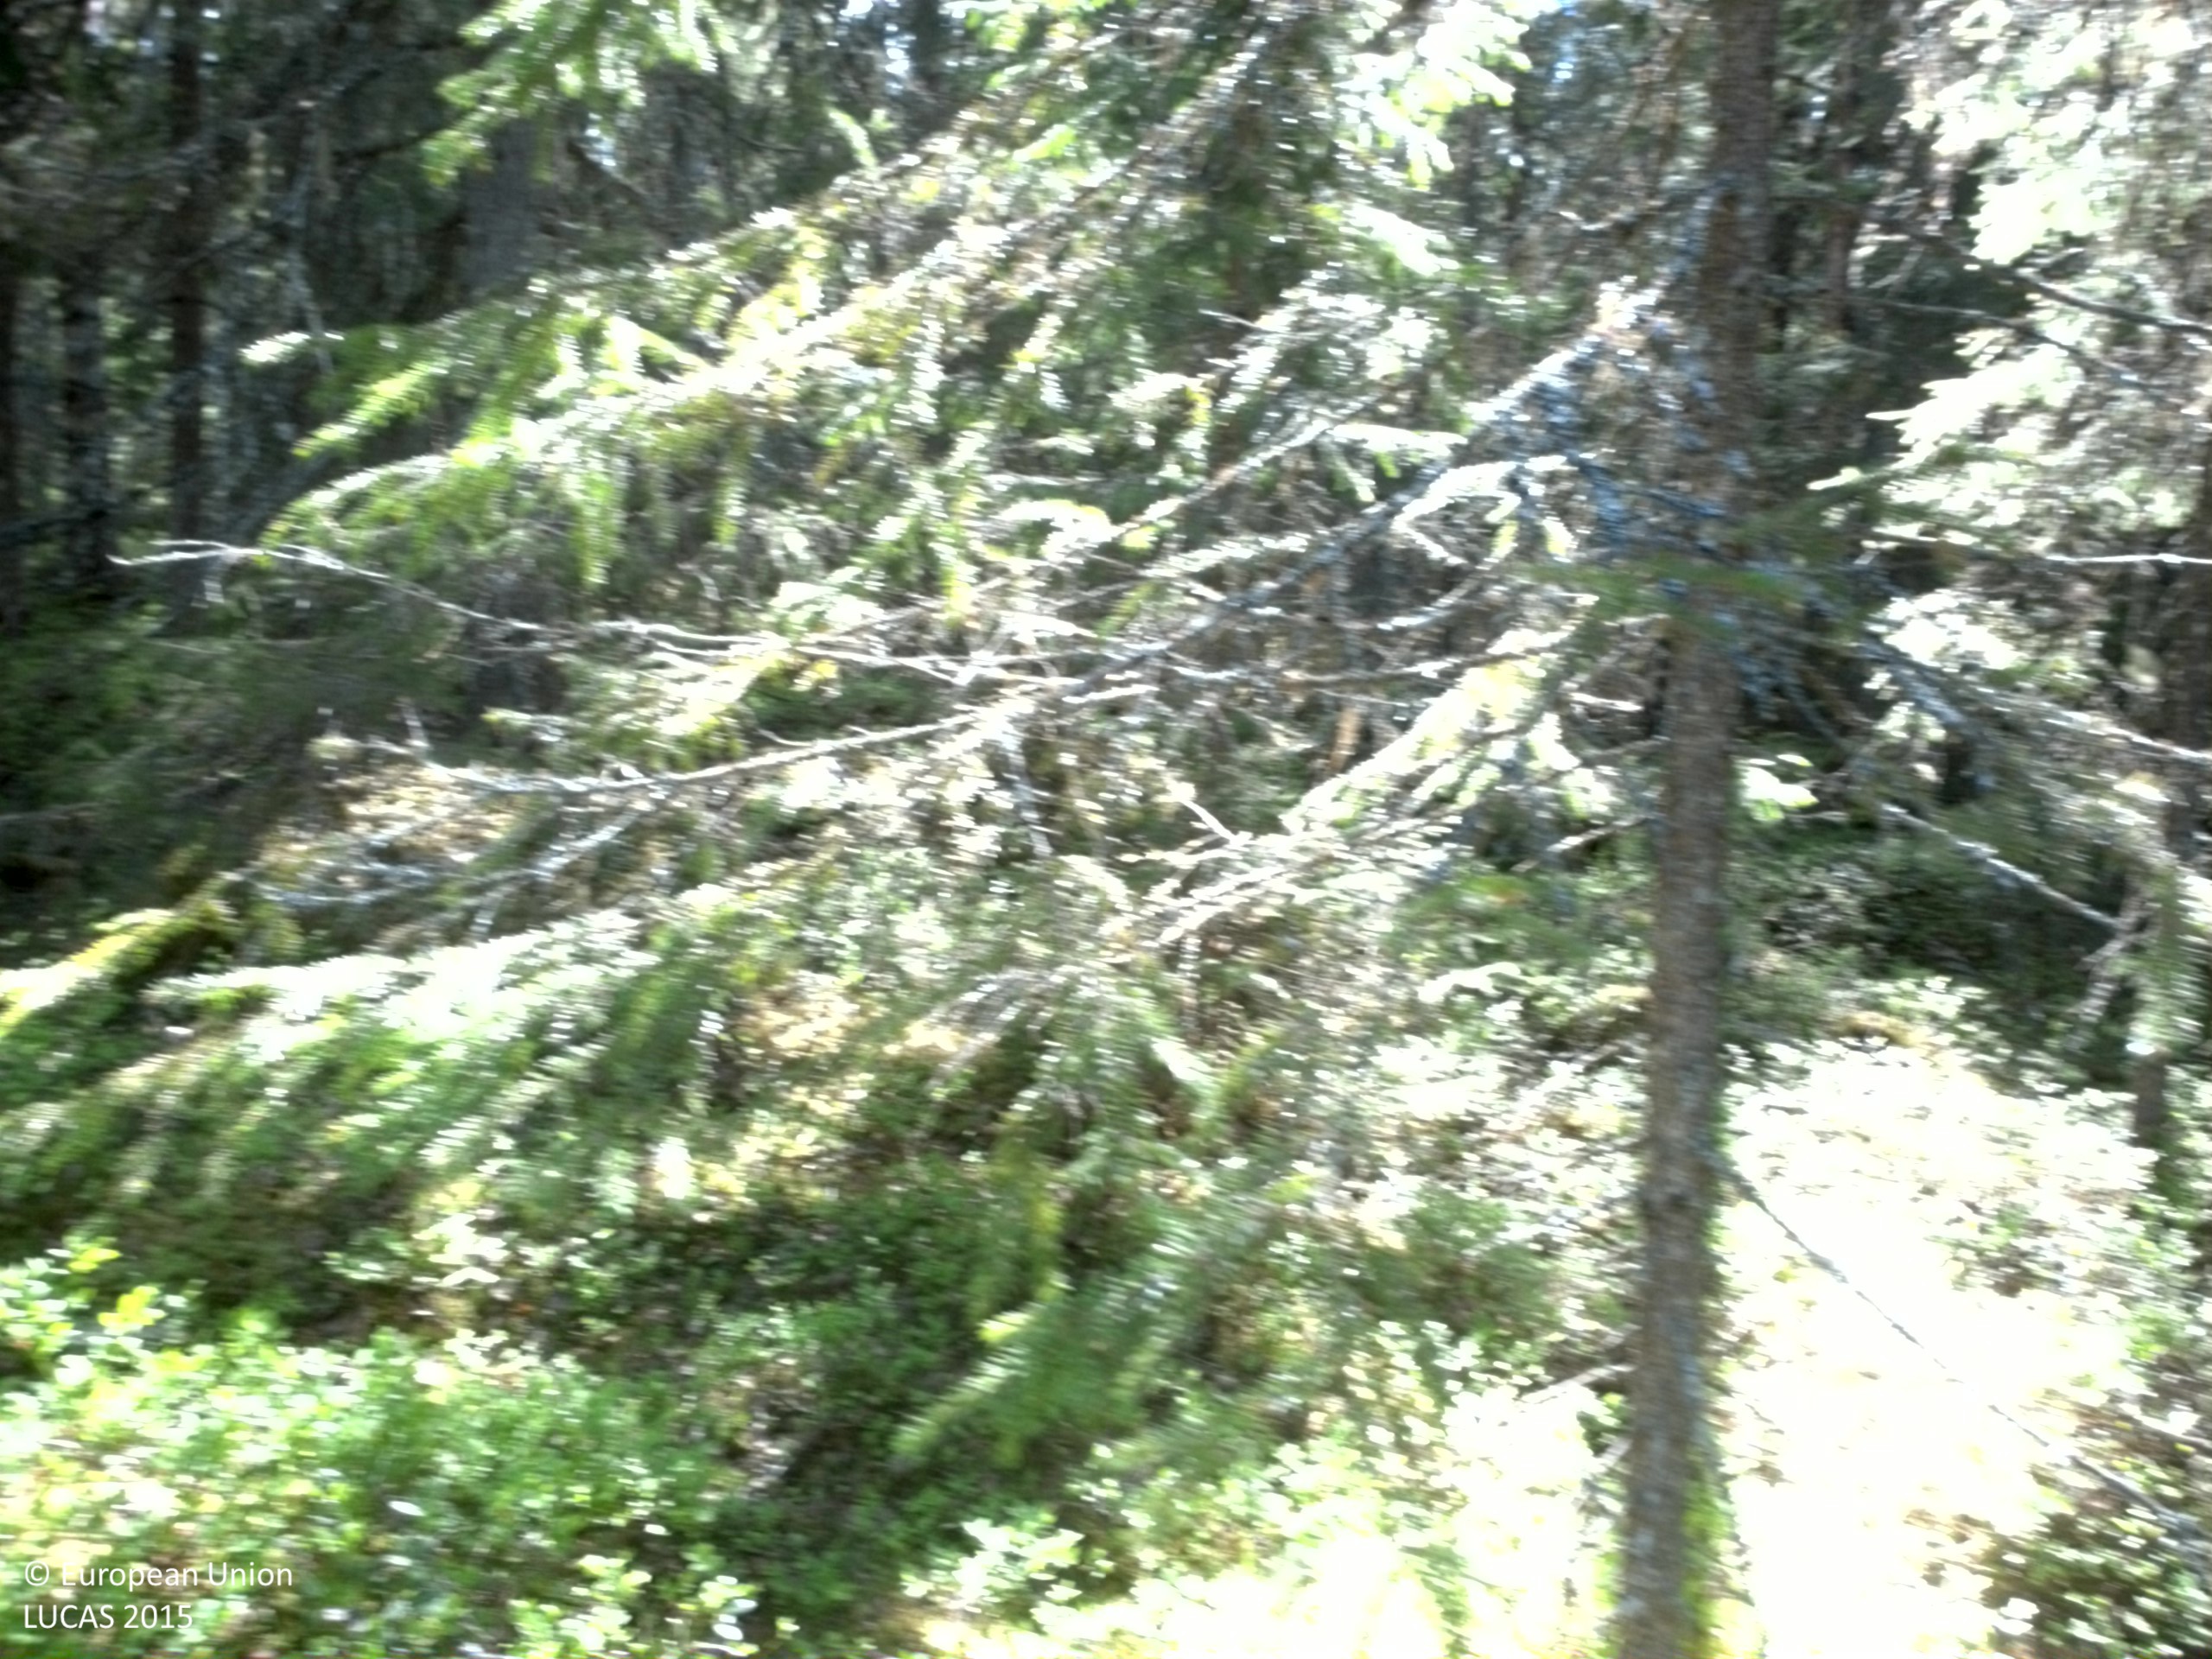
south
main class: Woodland
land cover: Spruce dominated coniferous woodland
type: boreal forest
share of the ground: > 75 %
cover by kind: coniferous forest trees 75 %, shrubs 25 %
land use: Forestry
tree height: > 5 m
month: June
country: SE
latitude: 62.9951
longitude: 17.3401
